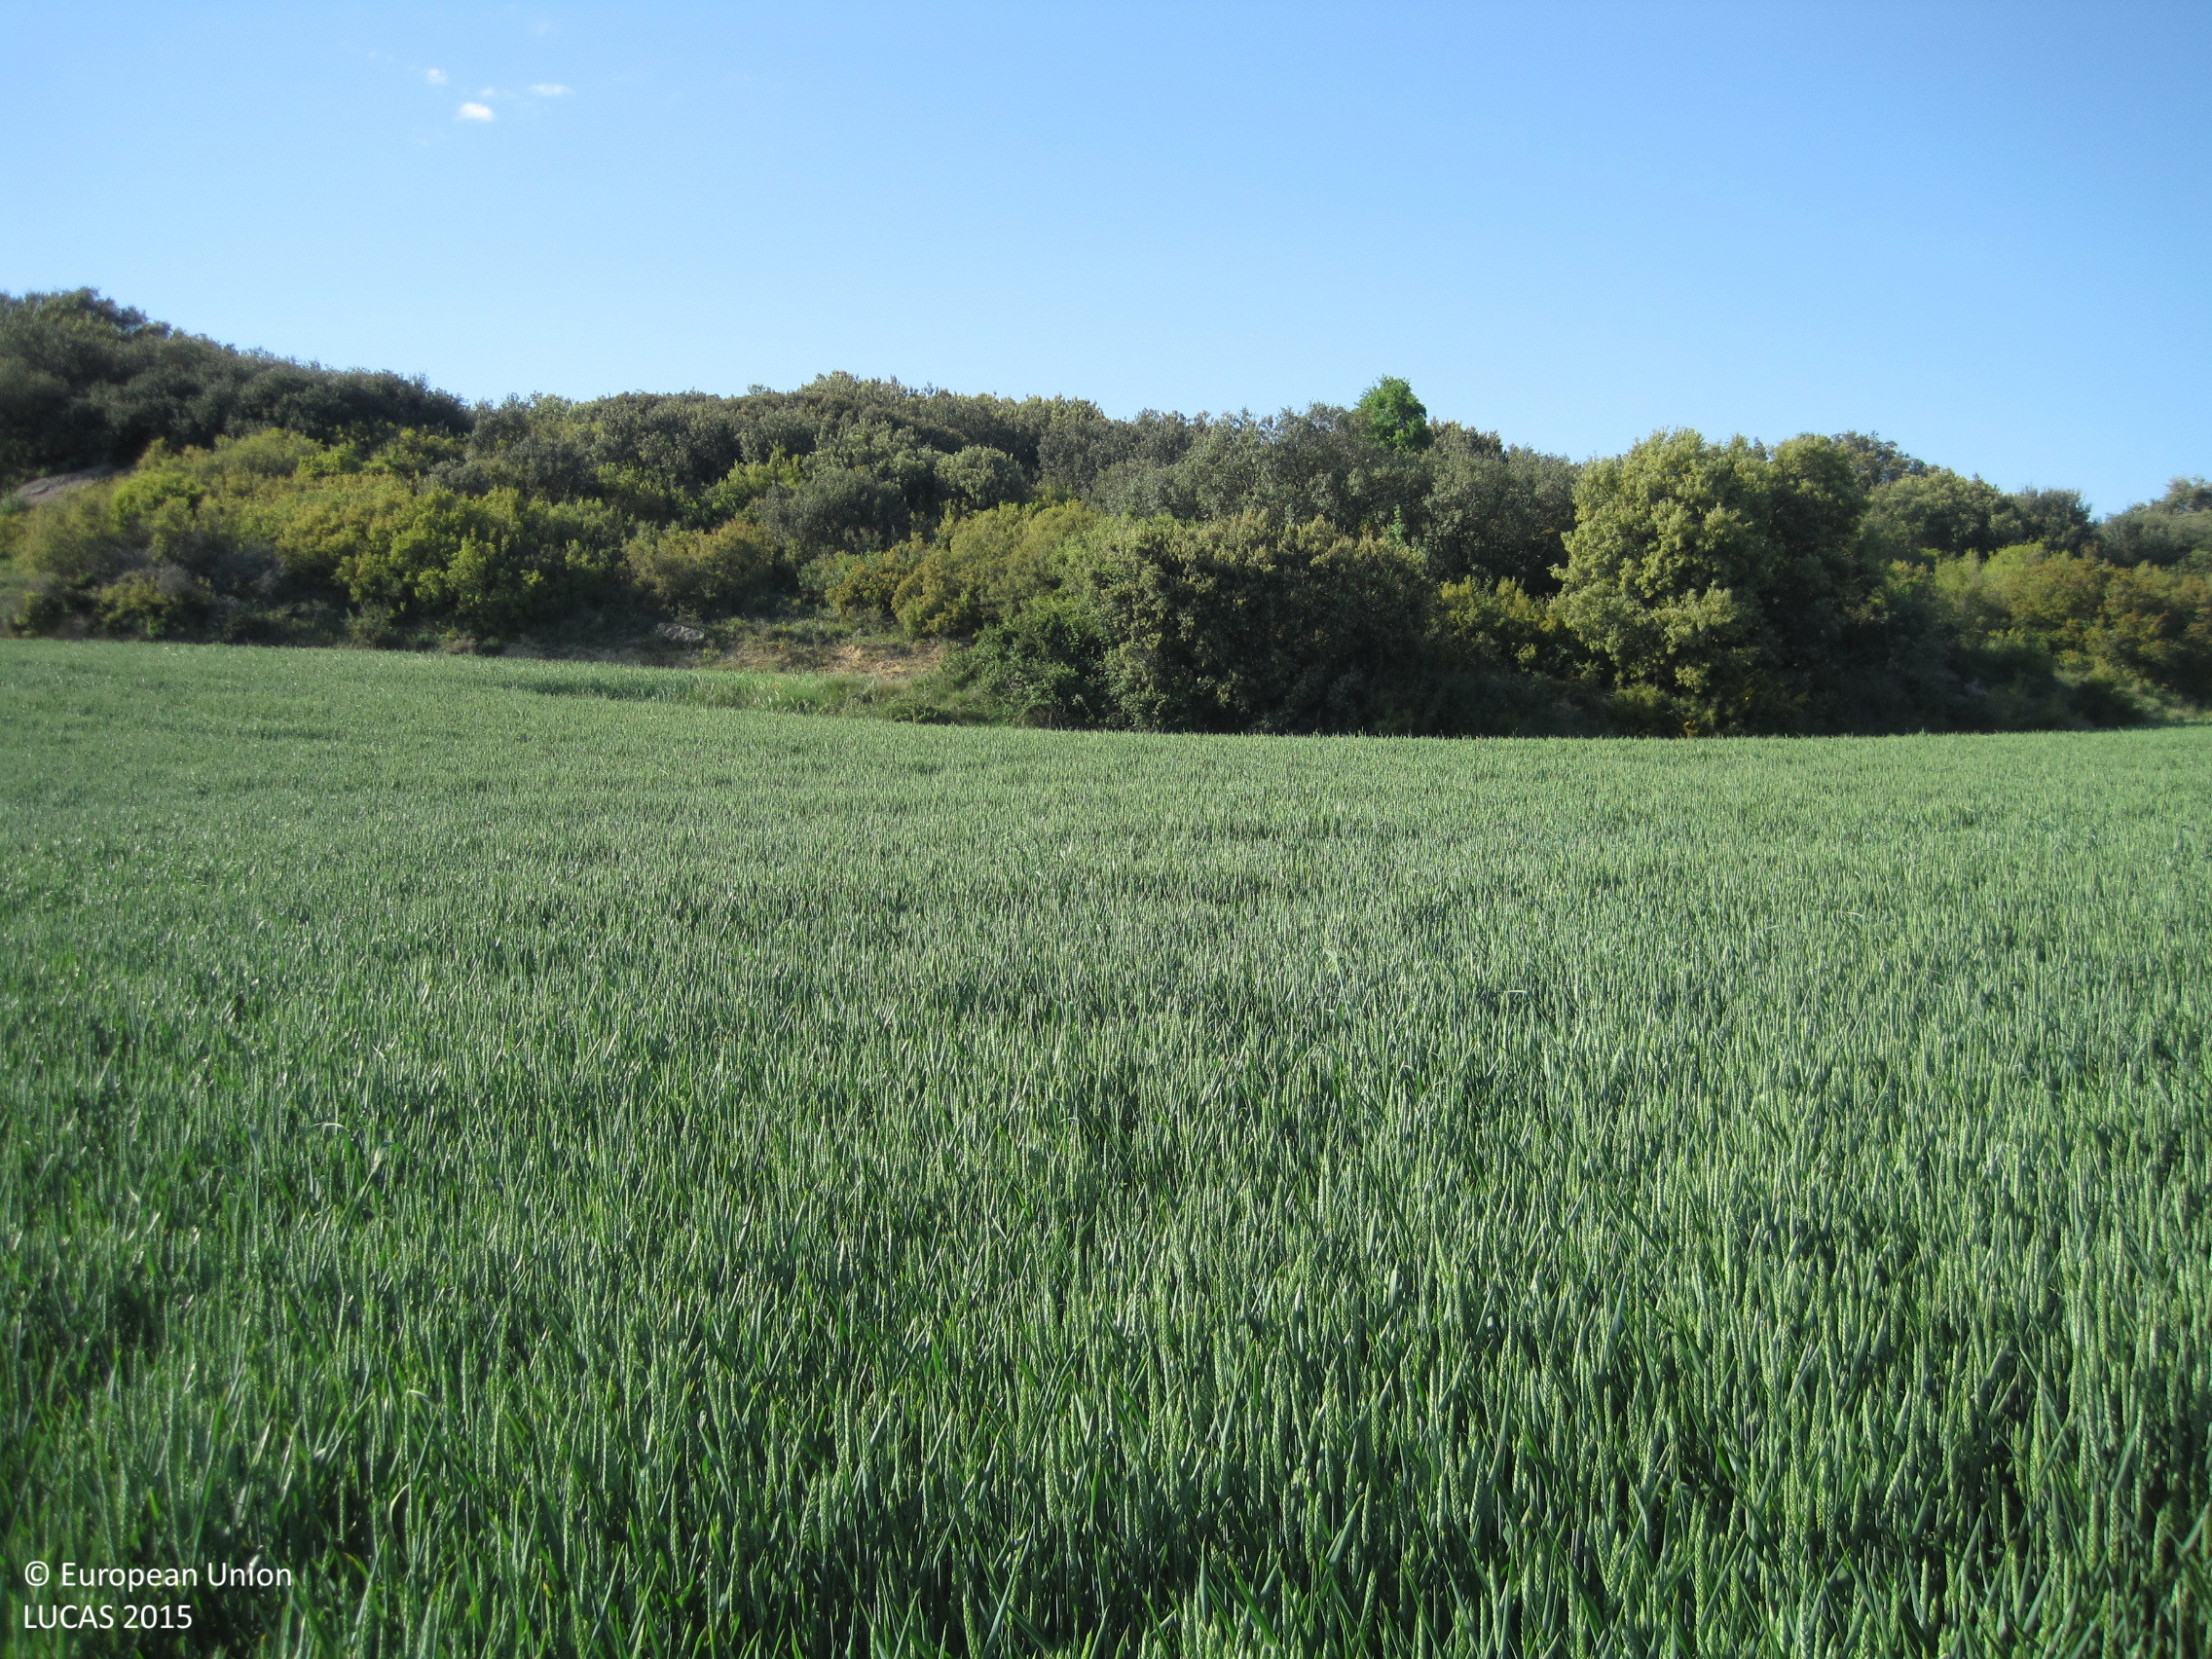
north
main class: Cropland
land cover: Common wheat
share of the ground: > 75 %
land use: Agriculture (excluding fallow land and kitchen gardens)
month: May
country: ES
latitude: 42.5754
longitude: -1.6968
